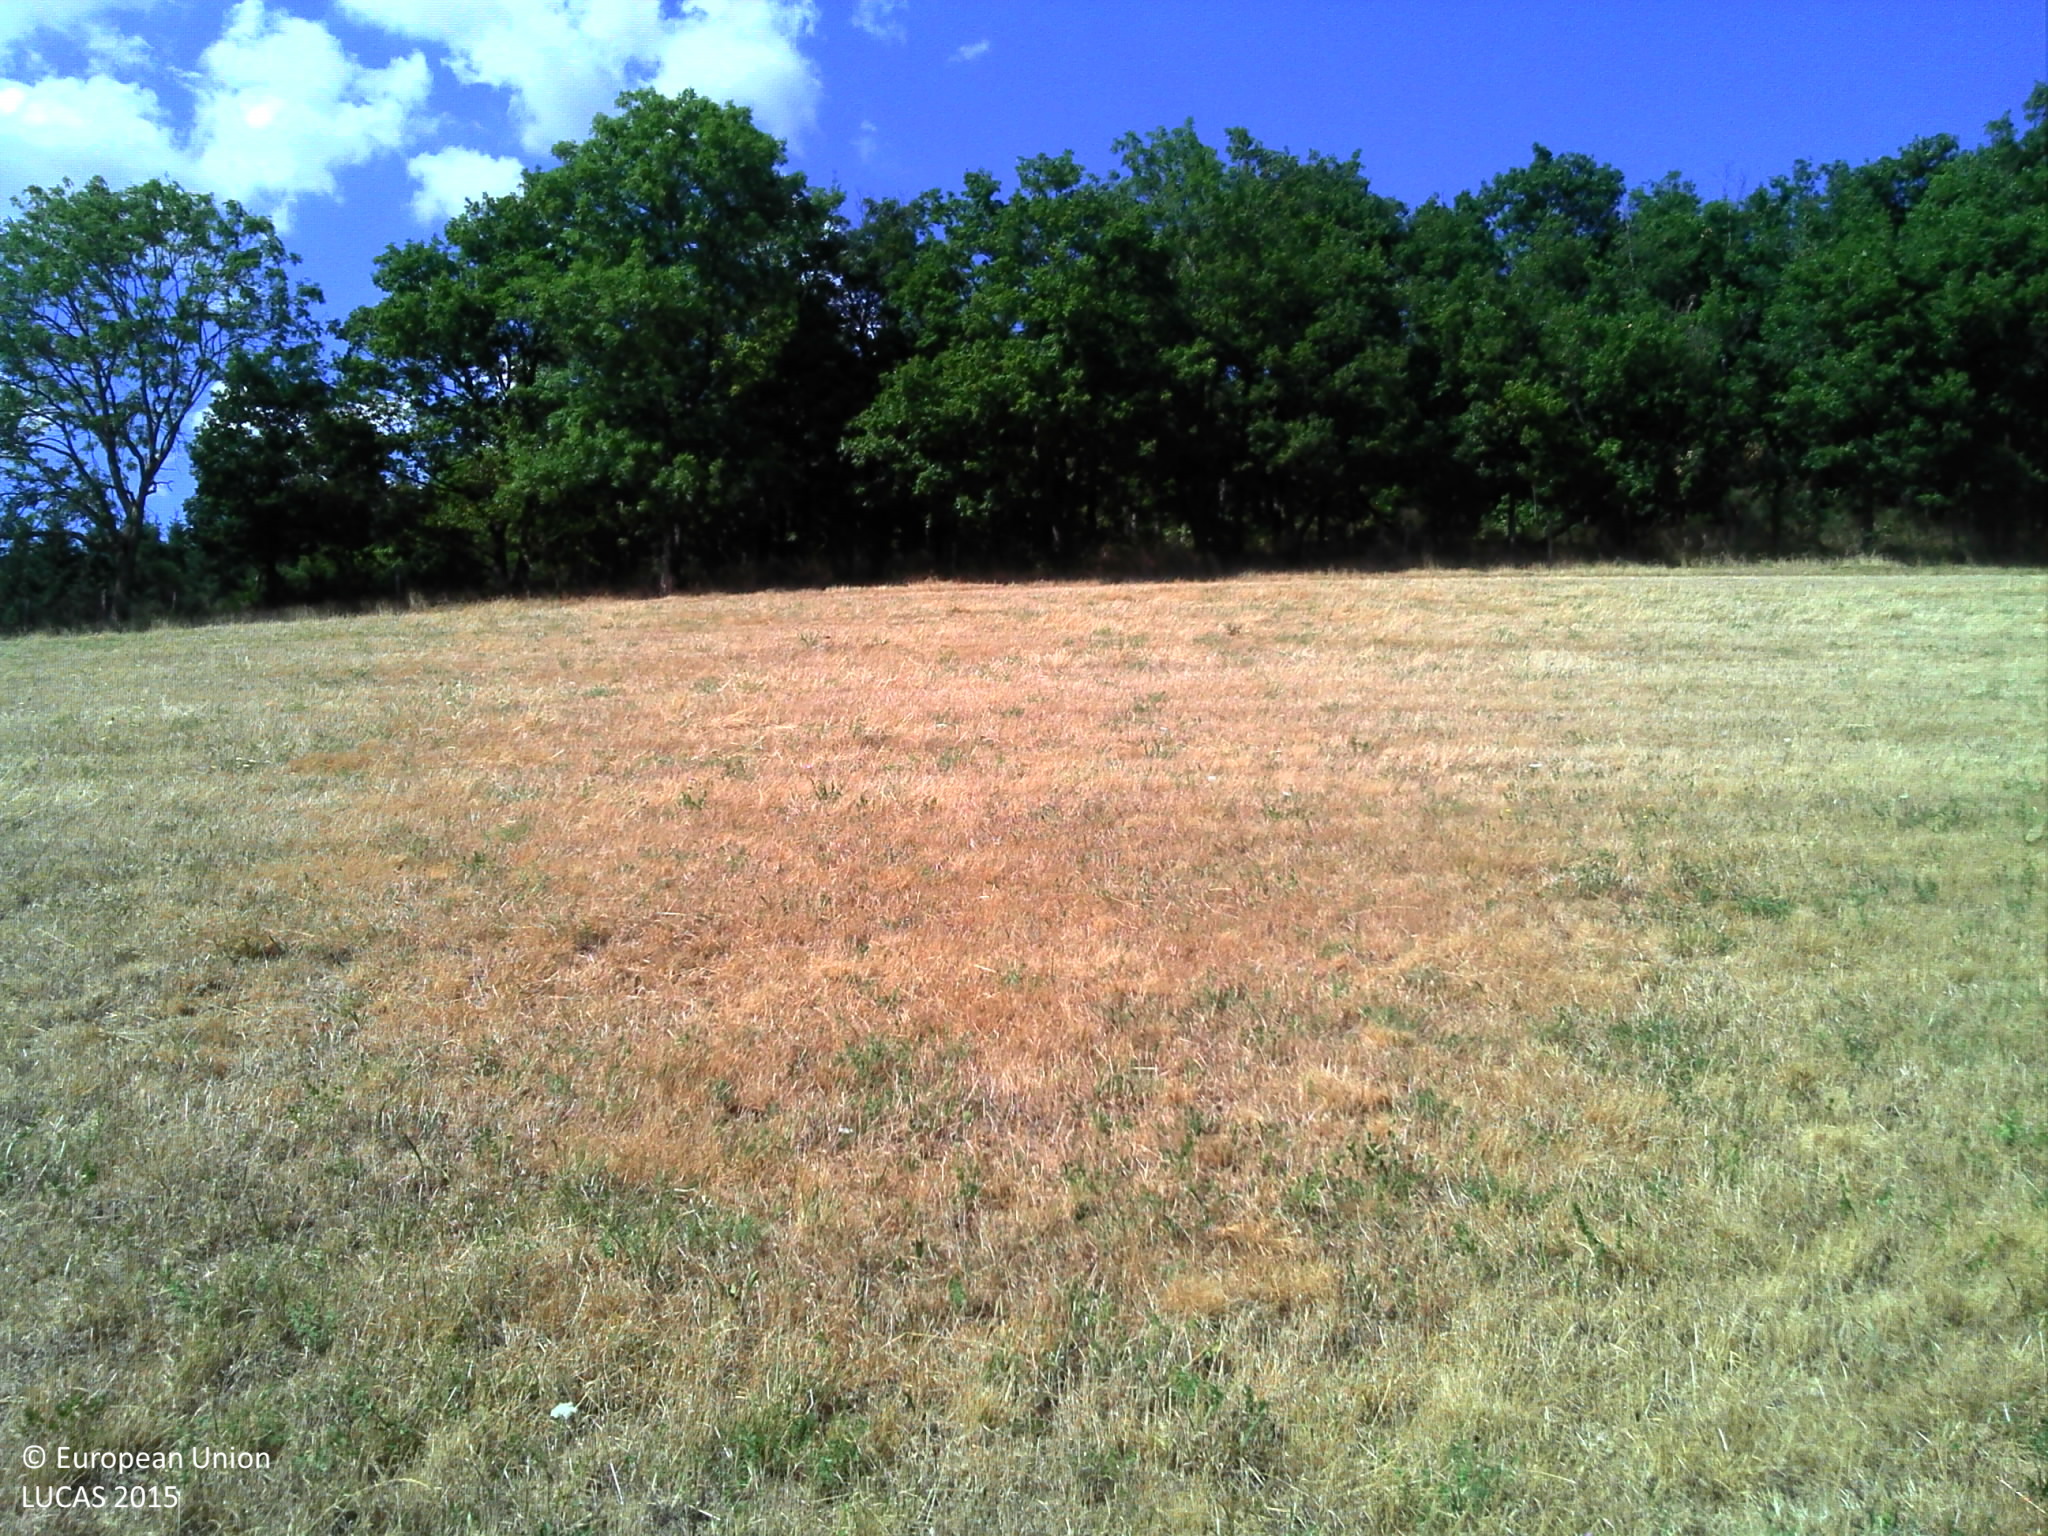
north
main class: Grassland
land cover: Grassland without tree/shrub cover
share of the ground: > 75 %
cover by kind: herbaceous plants 100 %
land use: Agriculture (excluding fallow land and kitchen gardens)
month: July
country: FR
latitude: 45.8821
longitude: 4.4493
